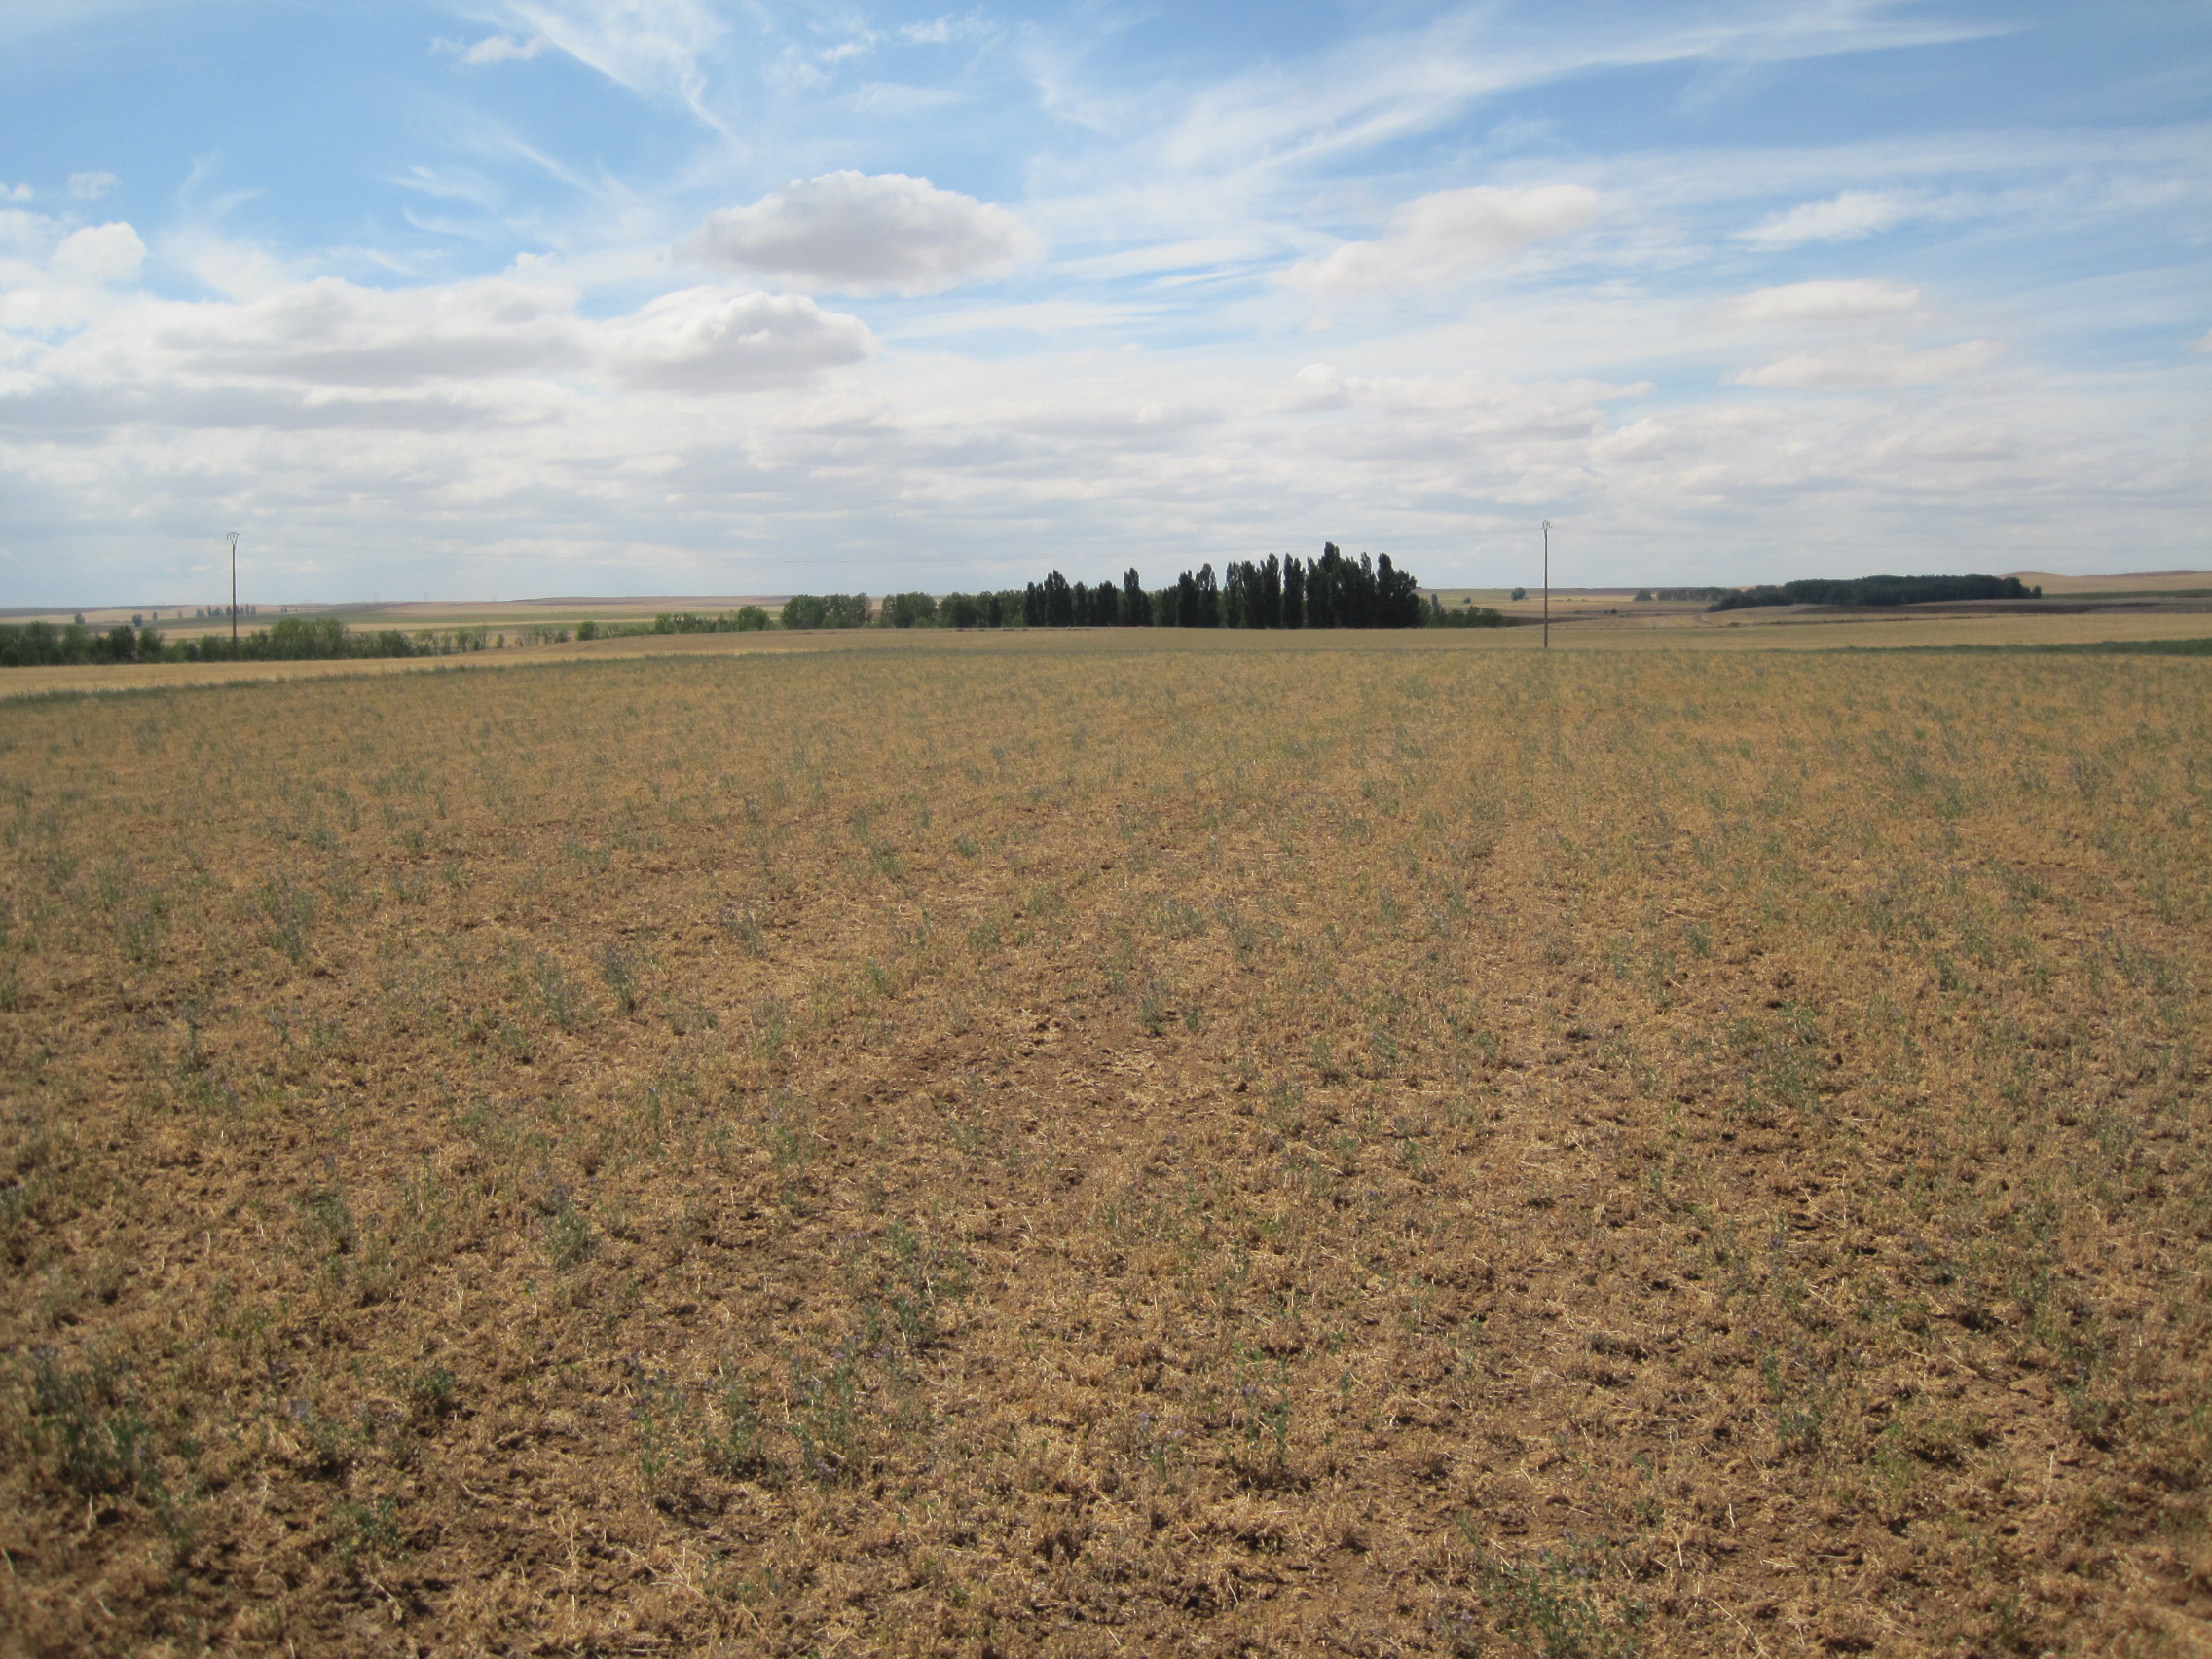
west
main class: Cropland
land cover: Lucerne
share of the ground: 25 - 50 %
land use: Agriculture (excluding fallow land and kitchen gardens)
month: July
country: ES
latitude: 41.9579
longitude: -5.1989
